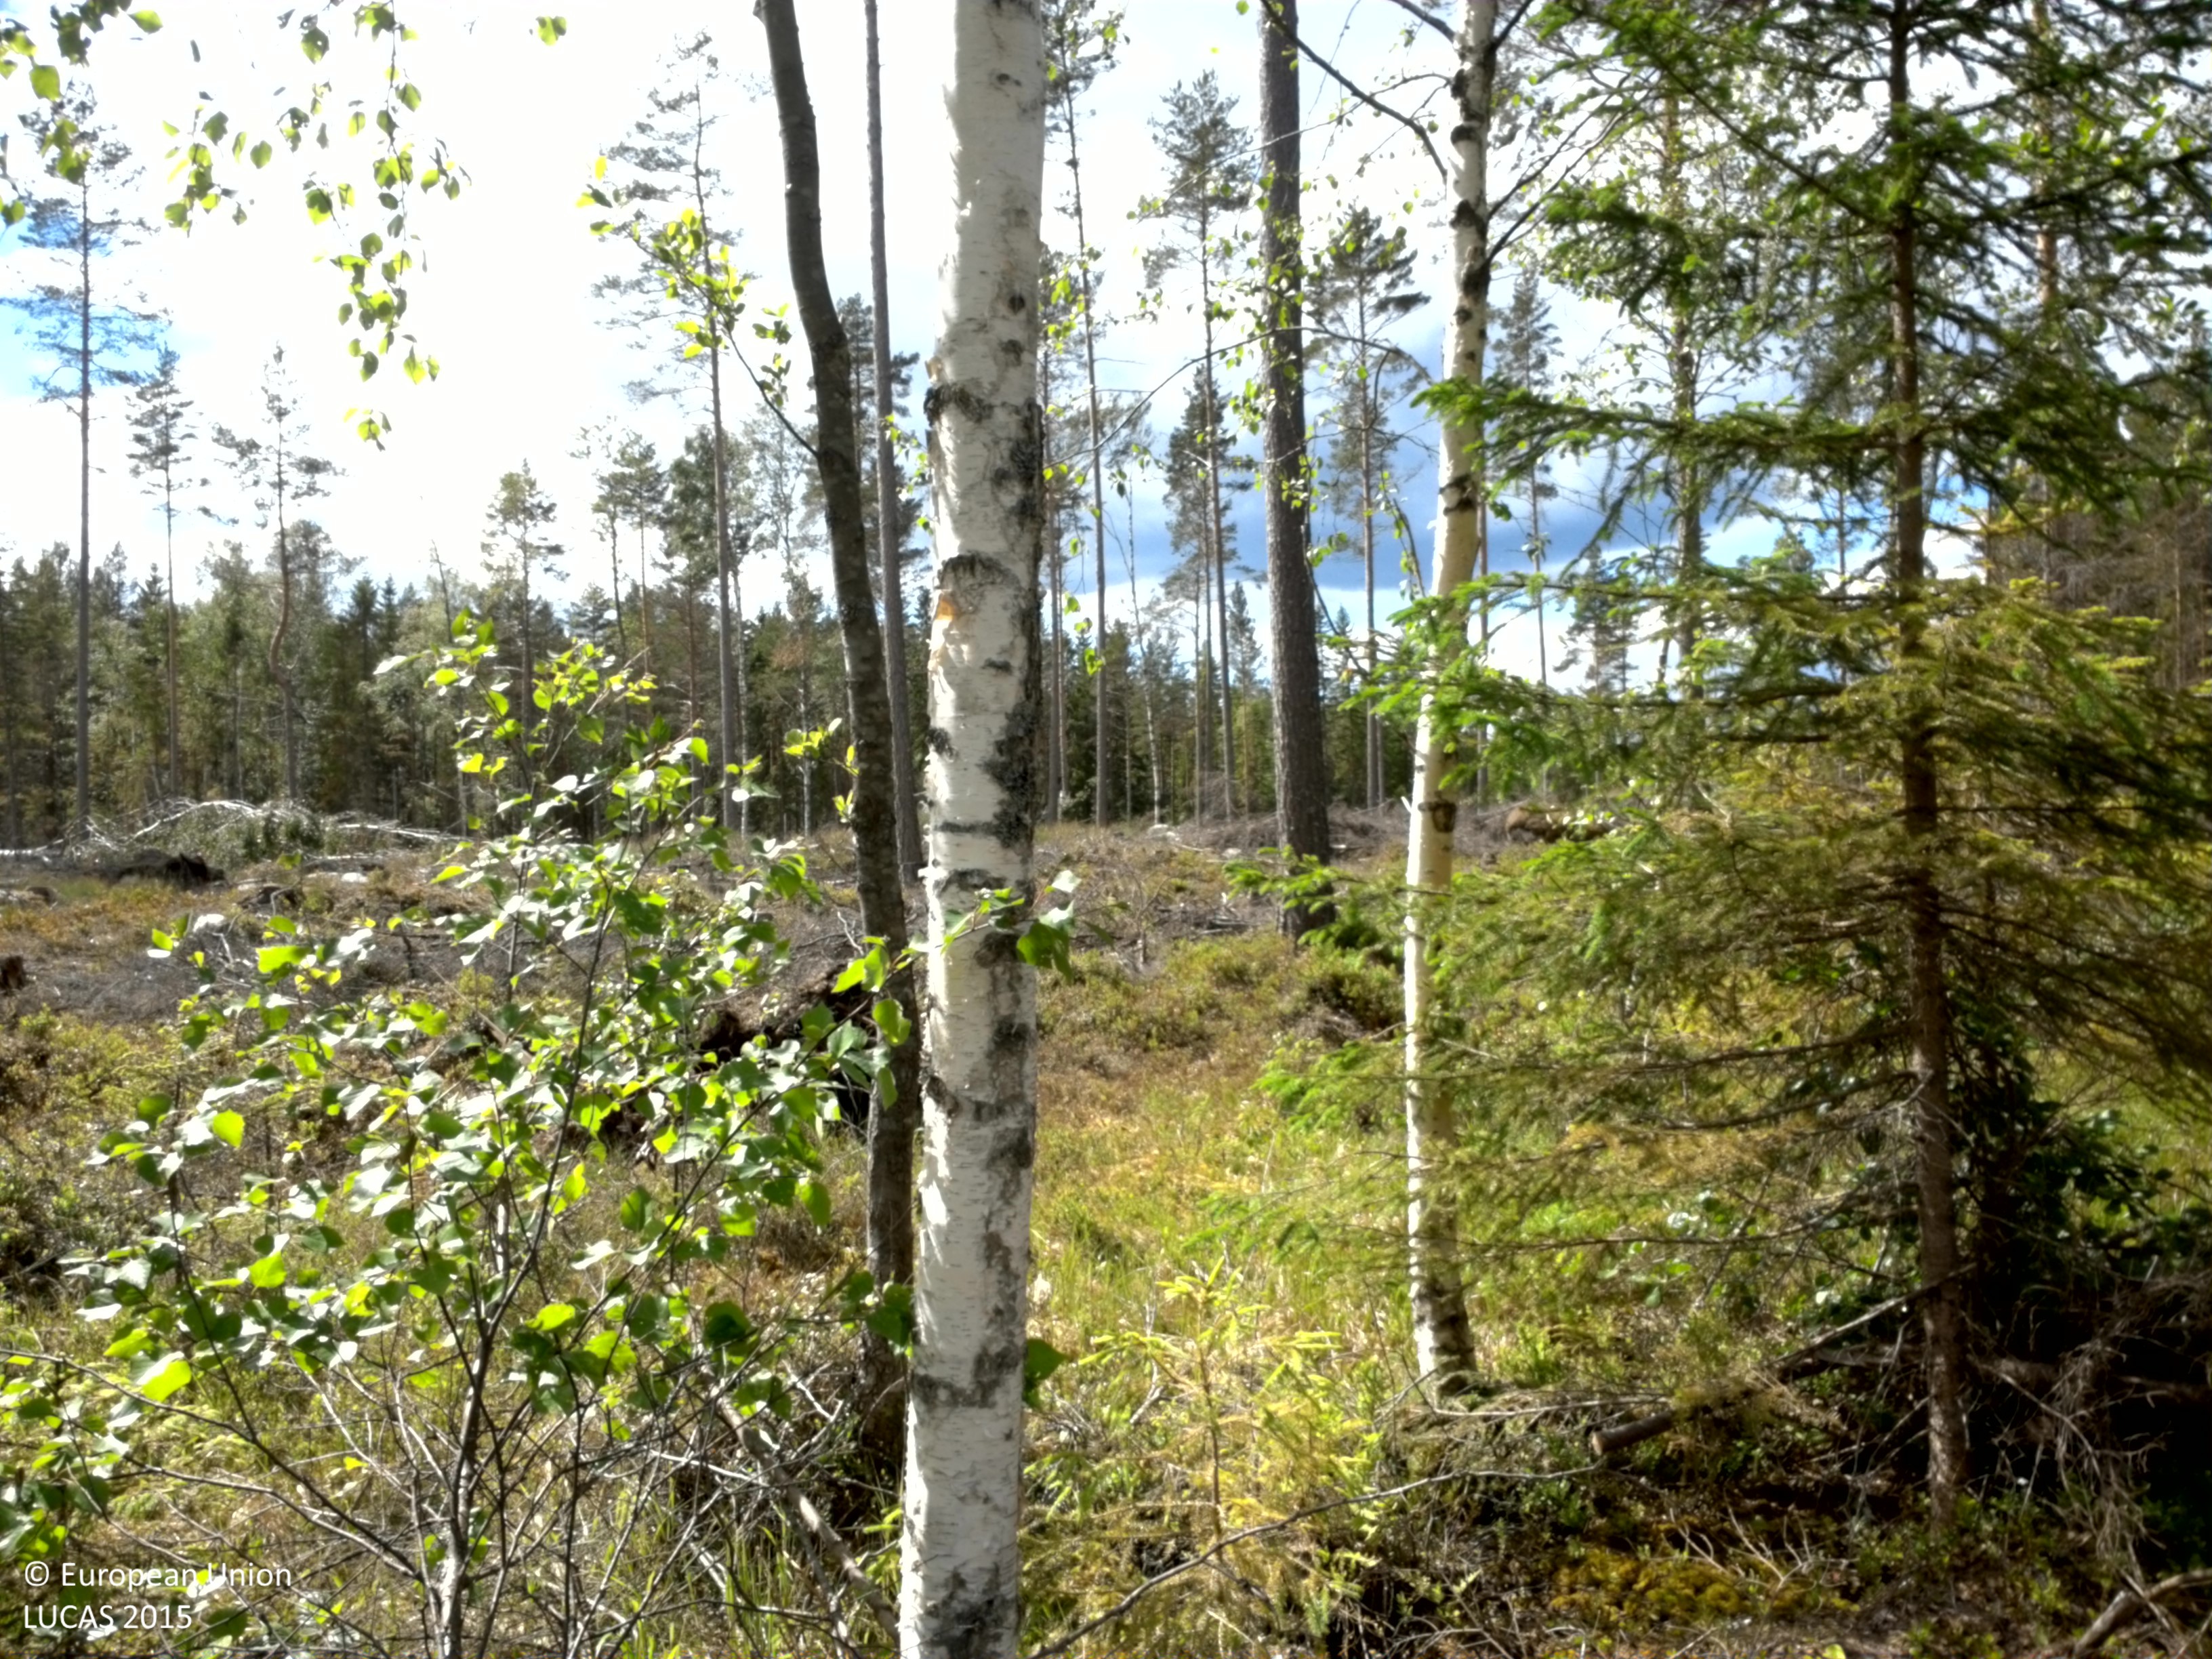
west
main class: Woodland
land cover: Broadleaved woodland
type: hemiboreal forest and nemoral coniferous forest and mixed broadleaved-coniferous forest
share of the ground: 10 - 25 %
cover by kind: herbaceous plants 35 %, broadleaved forest trees 15 %, coniferous forest trees 5 %, shrubs 5 %
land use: Forestry
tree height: > 5 m
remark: Clear cut
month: June
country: SE
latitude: 60.2035
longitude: 17.0450
